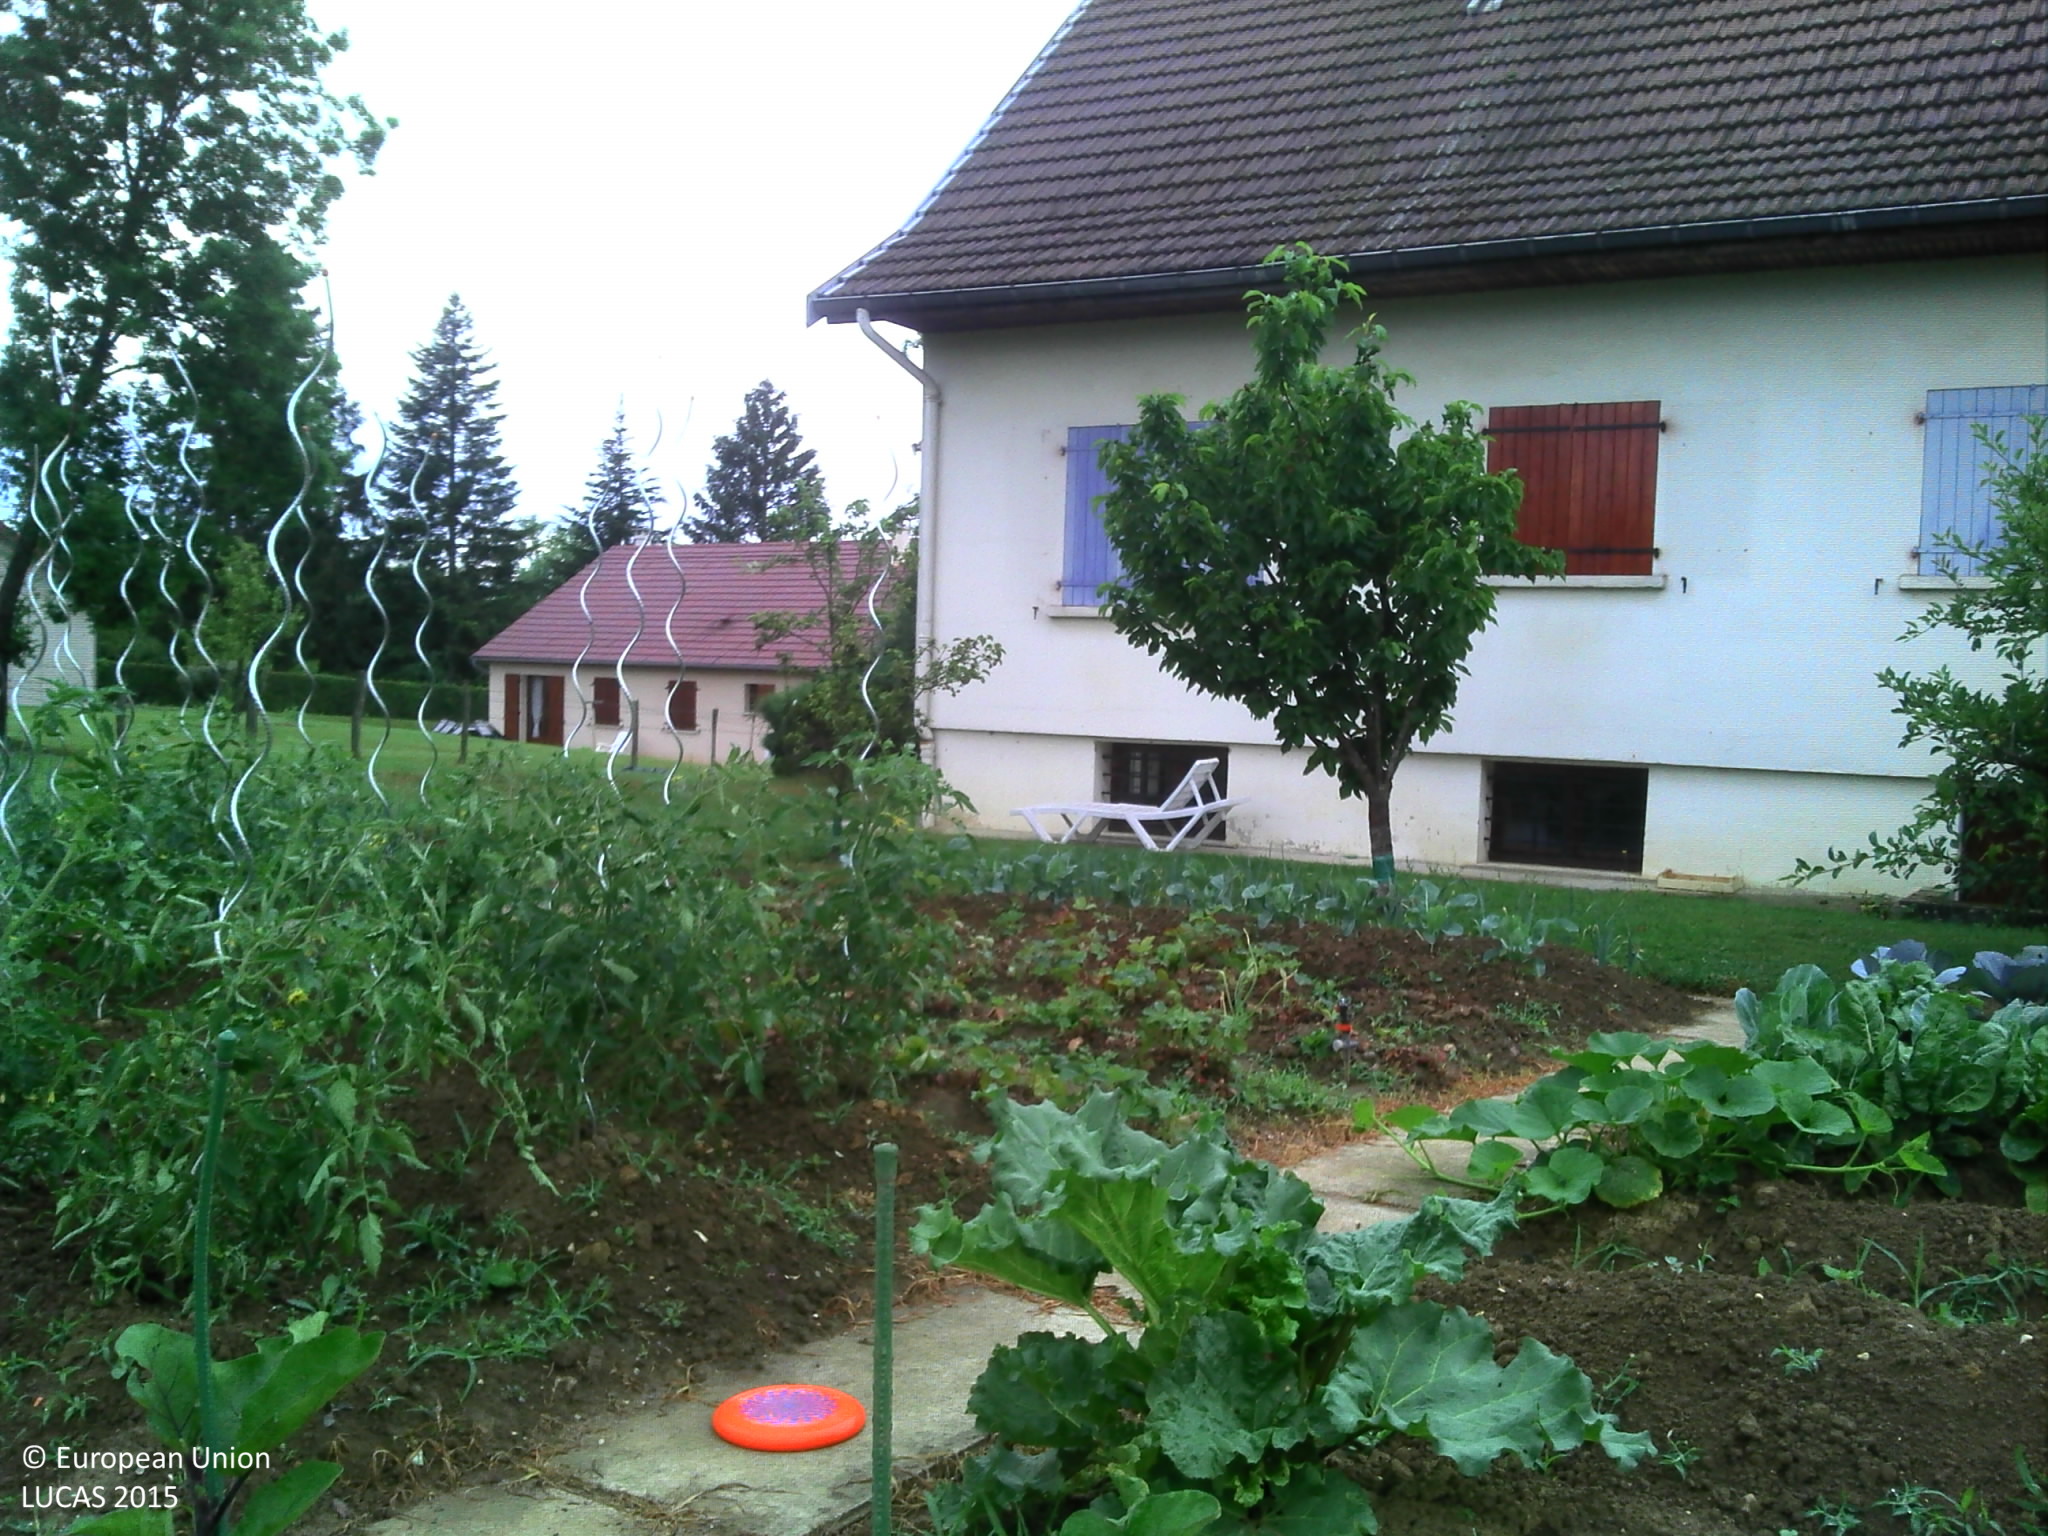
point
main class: Cropland
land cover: Other fresh vegetables
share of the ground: > 75 %
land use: Kitchen garden
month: June
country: FR
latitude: 46.6319
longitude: 5.4176
